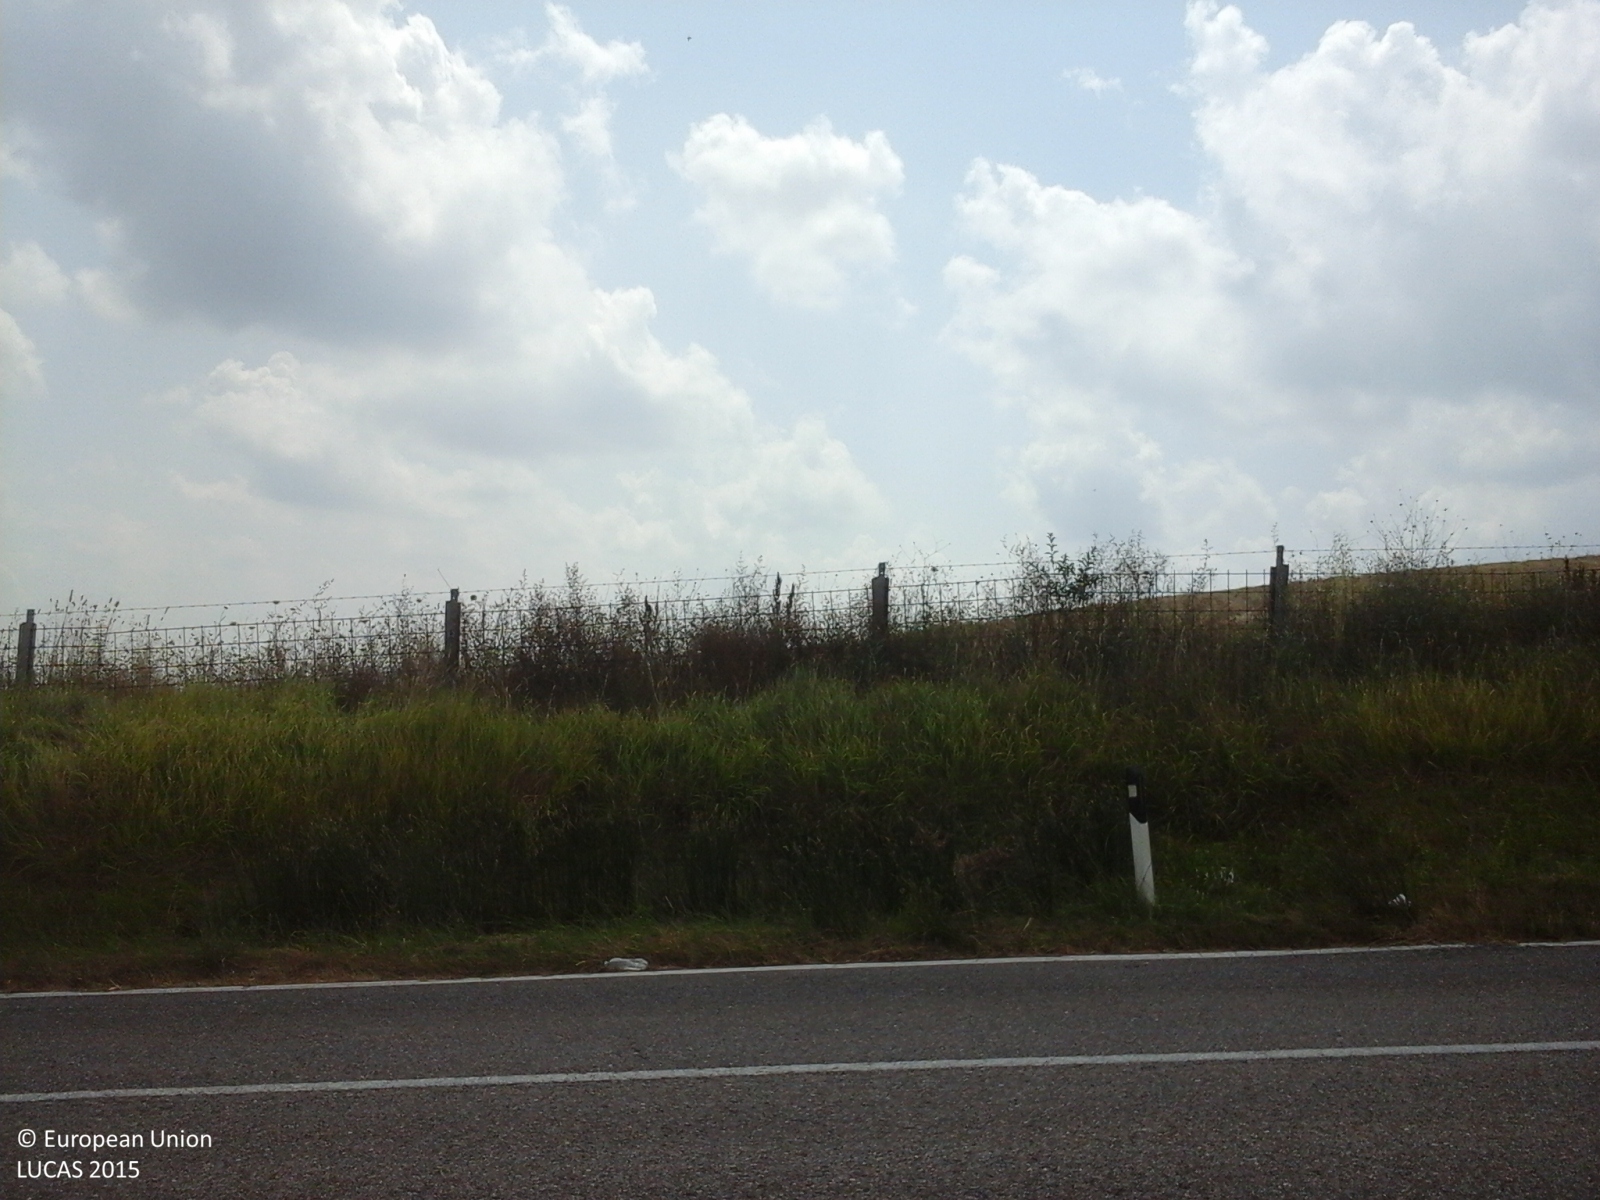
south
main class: Woodland
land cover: Broadleaved woodland
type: thermophilous deciduous forest
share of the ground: > 75 %
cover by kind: broadleaved forest trees 100 %
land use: Forestry
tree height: > 5 m
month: July
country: IT
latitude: 43.3901
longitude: 10.9232
